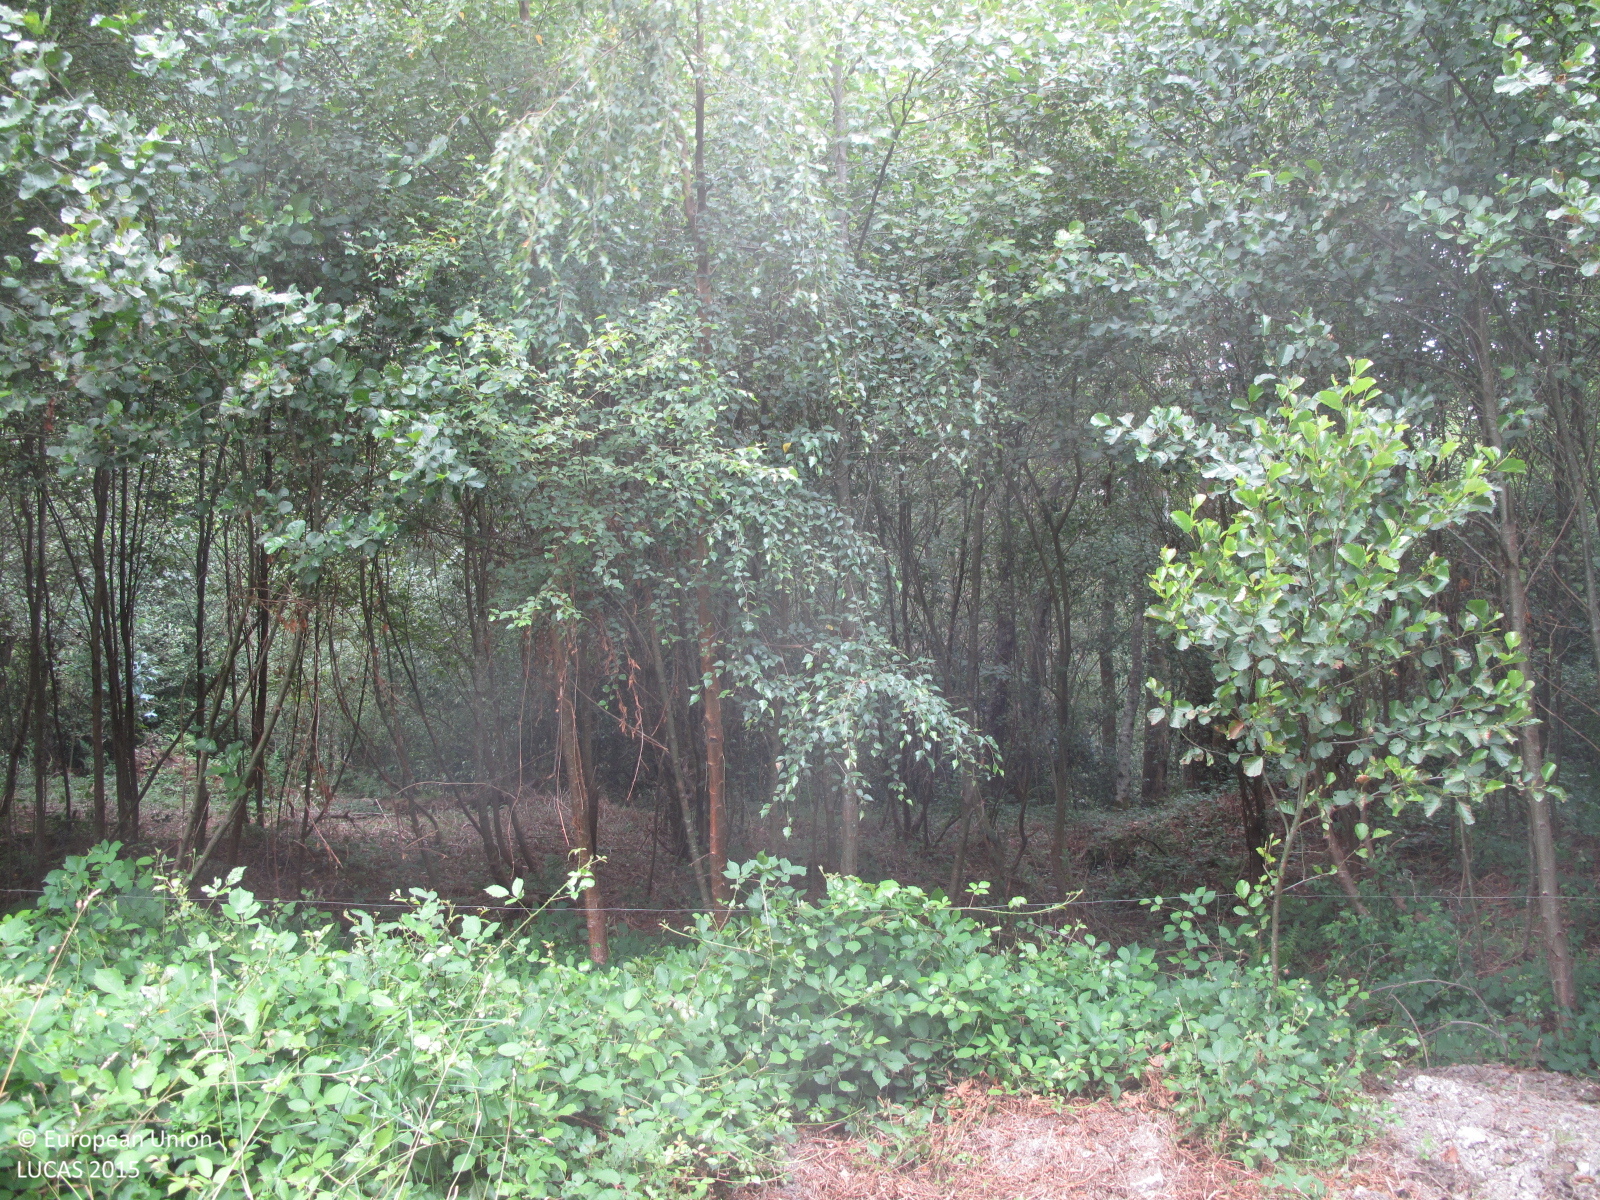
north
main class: Grassland
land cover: Grassland without tree/shrub cover
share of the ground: > 75 %
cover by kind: herbaceous plants 80 %, unconsolidated bare surface 20 %
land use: Agriculture (excluding fallow land and kitchen gardens)
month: July
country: ES
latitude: 43.2293
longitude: -8.5668
